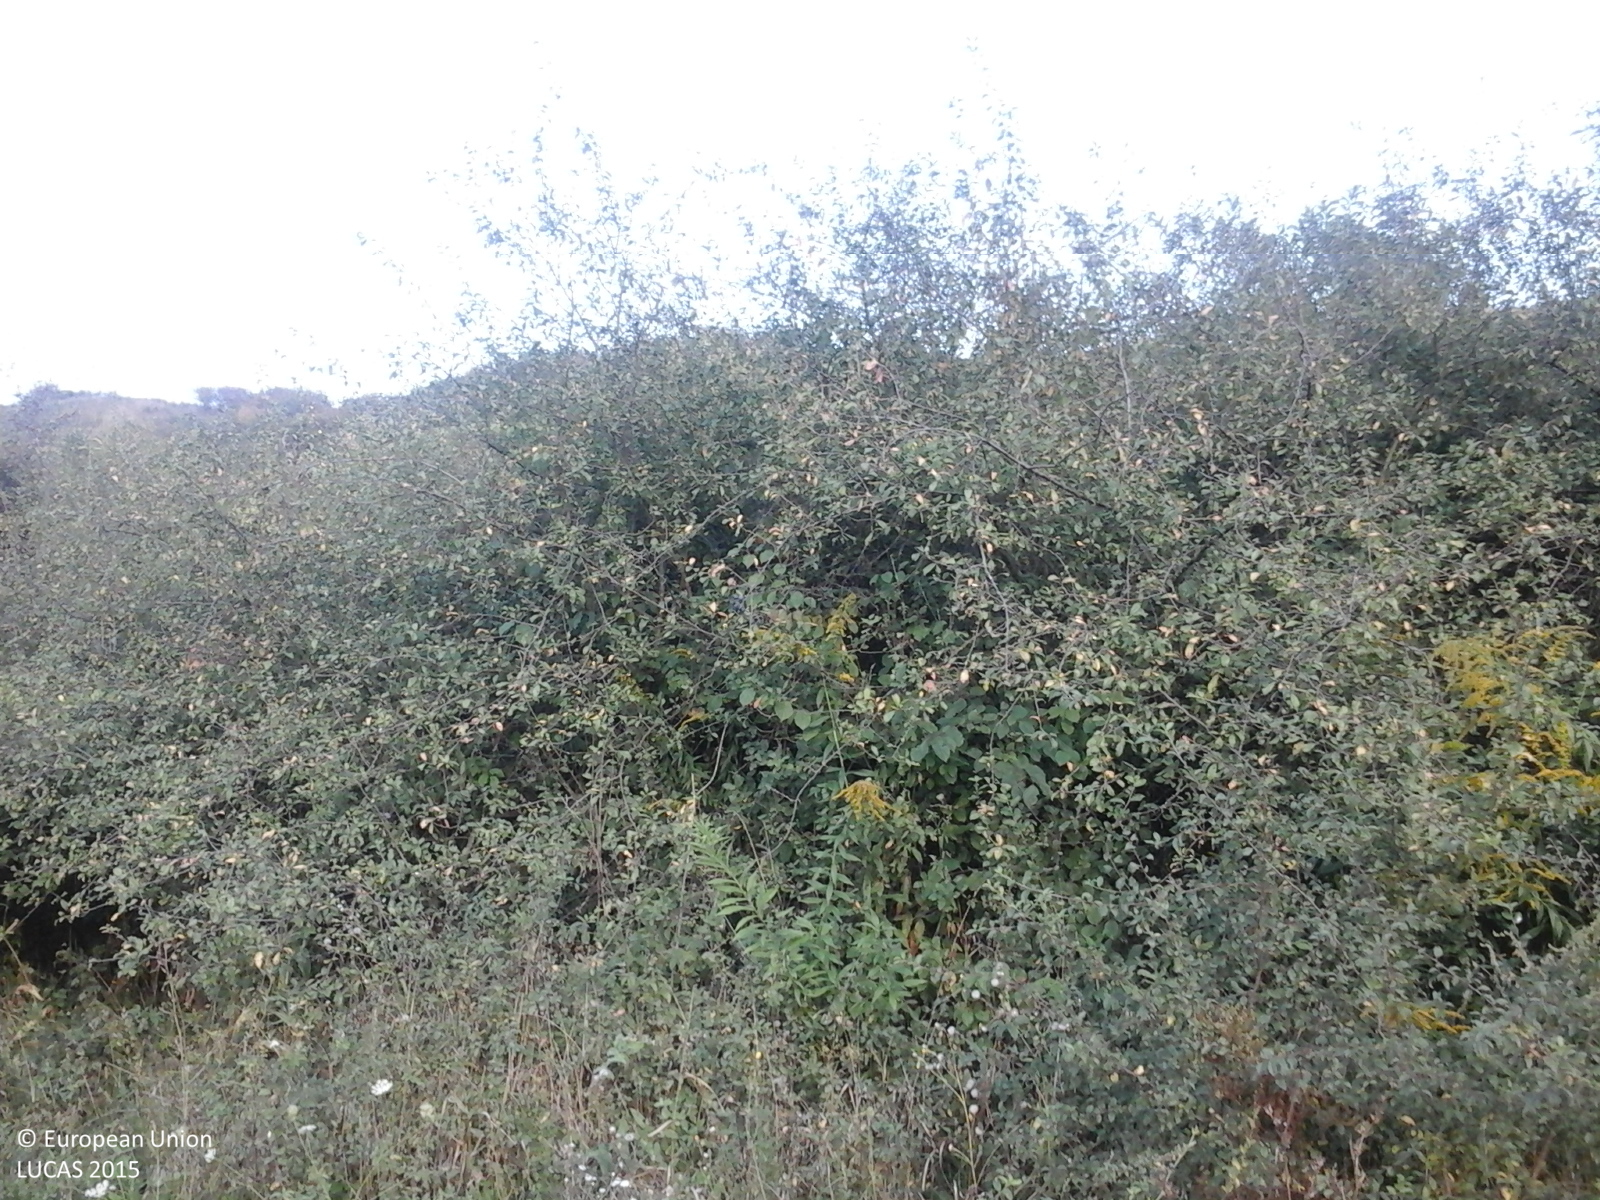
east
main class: Shrubland
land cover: Shrubland with sparse tree cover
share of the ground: > 75 %
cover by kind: shrubs 95 %, broadleaved forest trees 5 %
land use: Fallow land
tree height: > 5 m
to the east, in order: Shrubland with sparse tree cover; Grassland with sparse tree/shrub cover; Abandoned hedges; Grassland without tree/shrub cover; Abandoned hedges; Grassland without tree/shrub cover; Abandoned hedges; Grassland without tree/shrub cover; Abandoned hedges; Grassland without tree/shrub cover
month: September
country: RO
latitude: 47.0065
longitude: 24.1969
